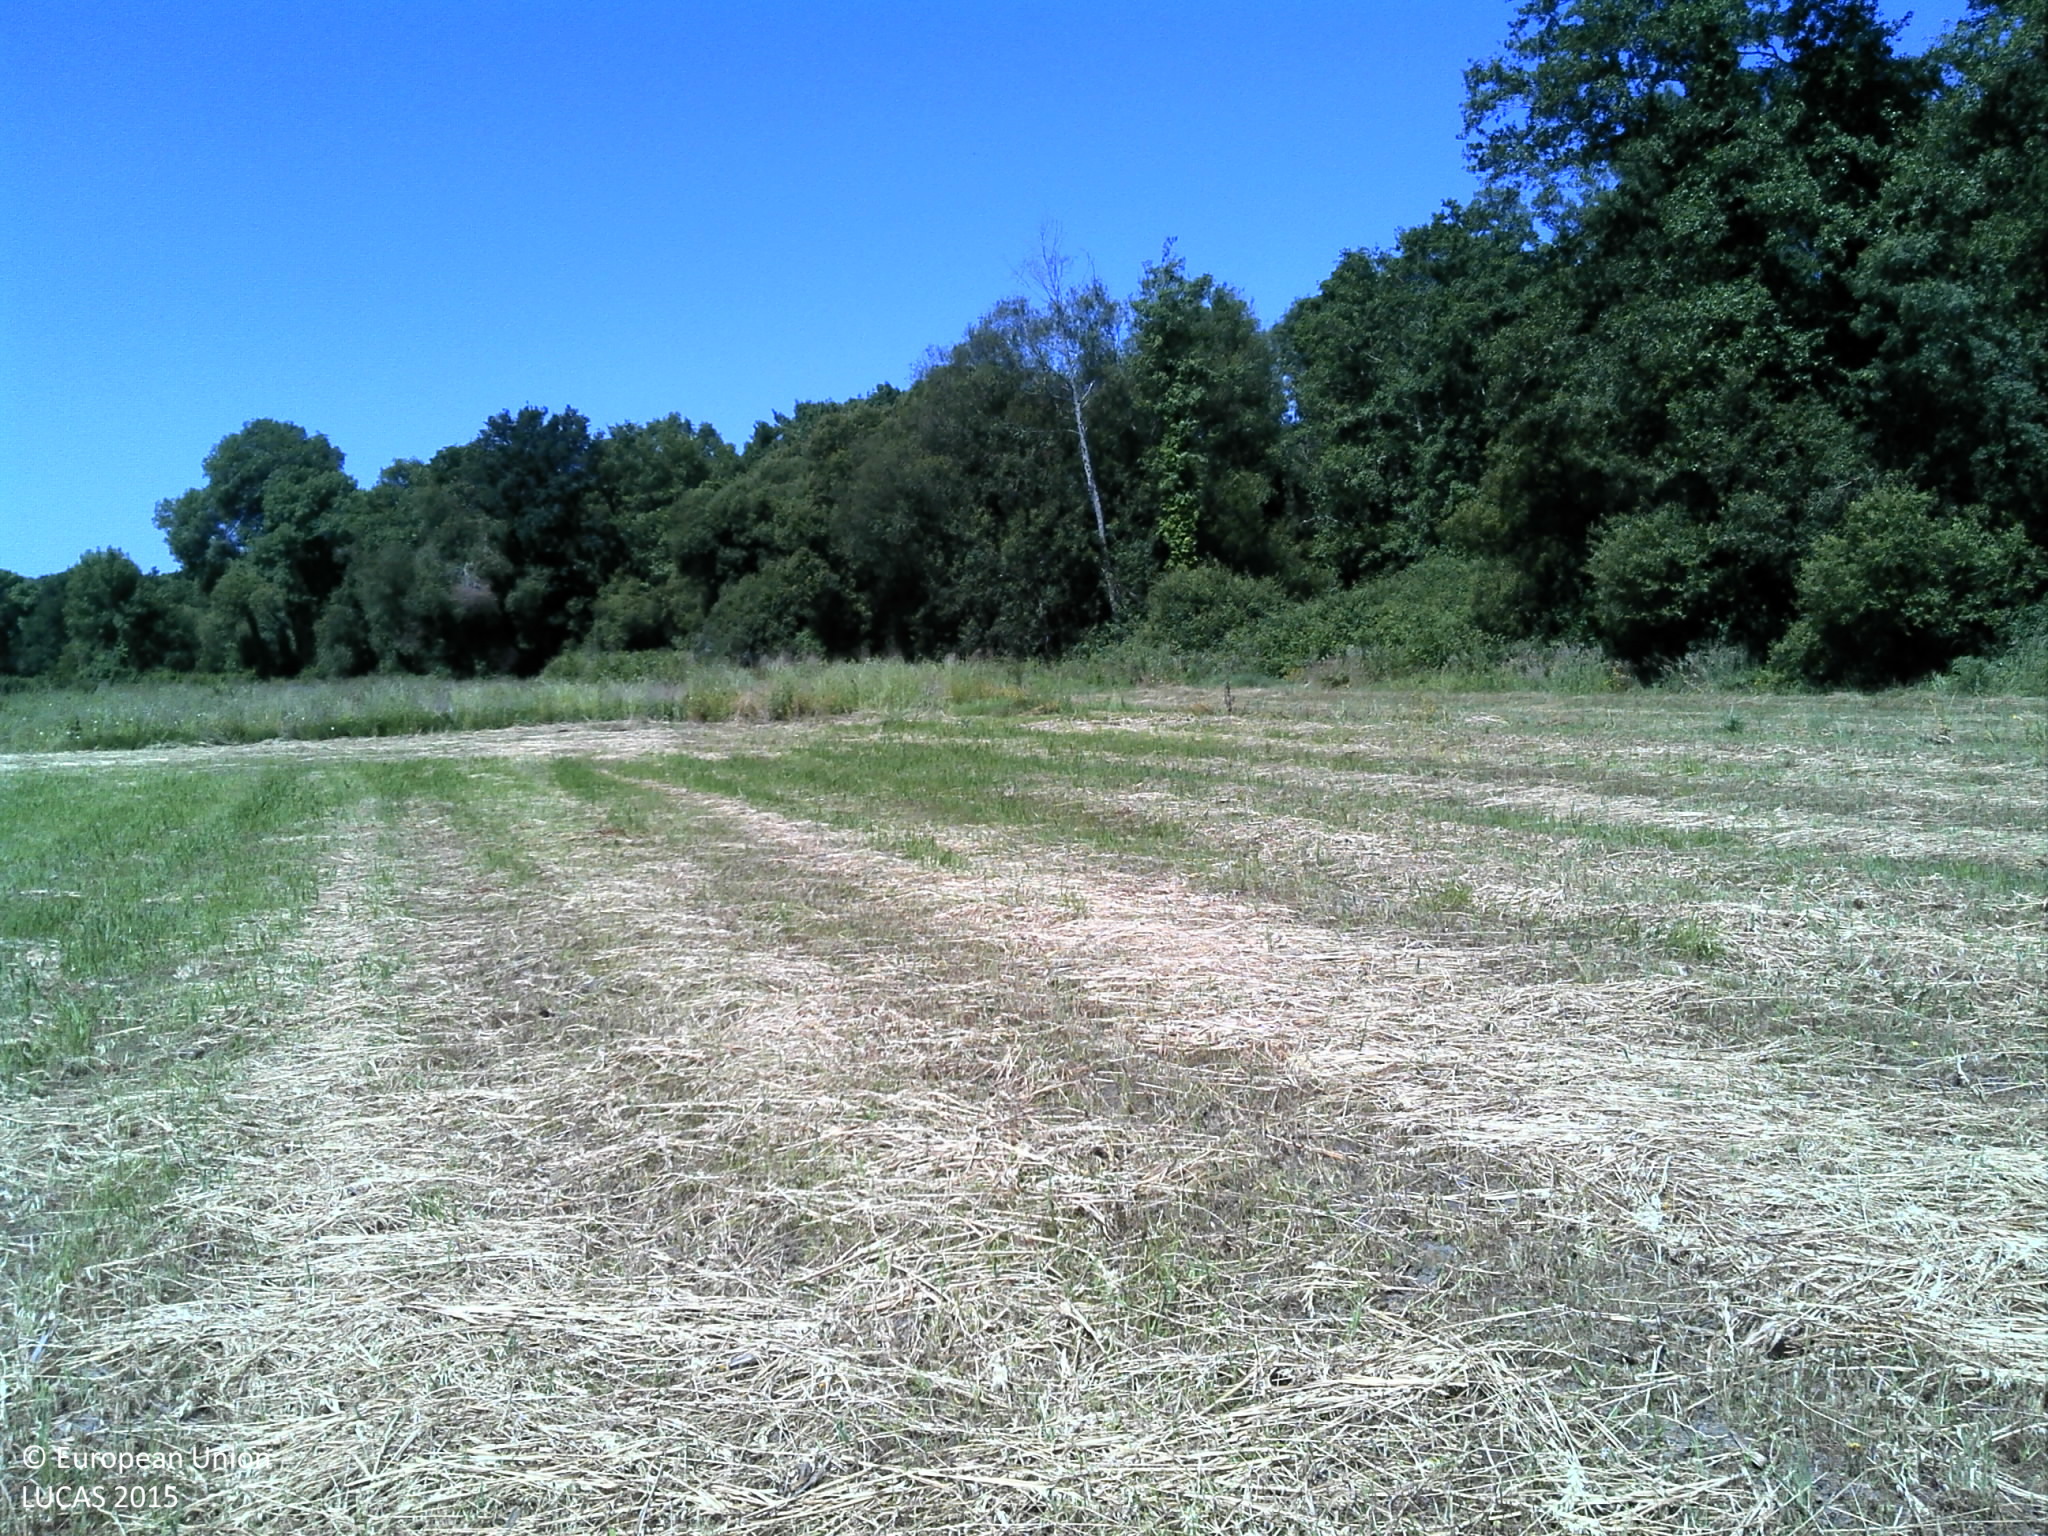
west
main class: Grassland
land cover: Spontaneously vegetated surfaces
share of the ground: < 10 %
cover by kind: unconsolidated bare surface 90 %, herbaceous plants 10 %
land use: Agriculture (excluding fallow land and kitchen gardens)
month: May
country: PT
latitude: 41.7278
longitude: -8.6902
